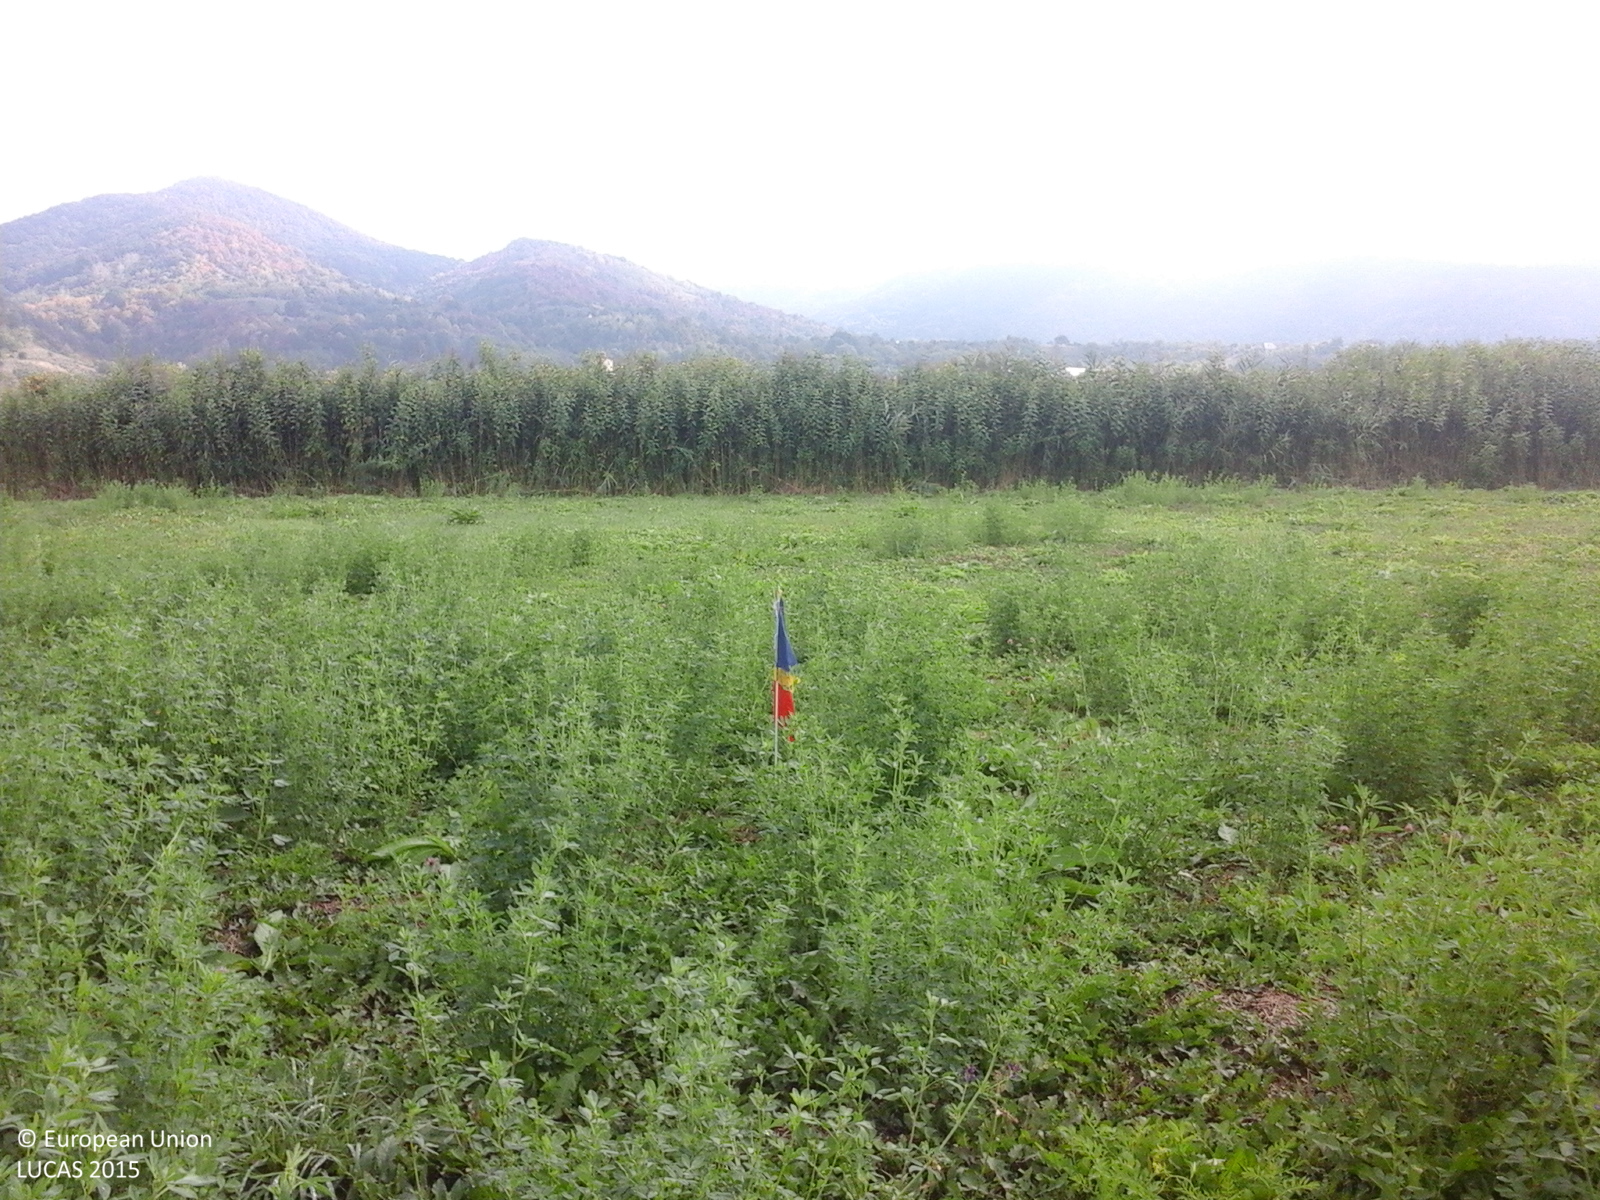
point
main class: Cropland
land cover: Lucerne
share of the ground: > 75 %
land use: Agriculture (excluding fallow land and kitchen gardens)
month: September
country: RO
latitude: 47.6947
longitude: 23.3839
